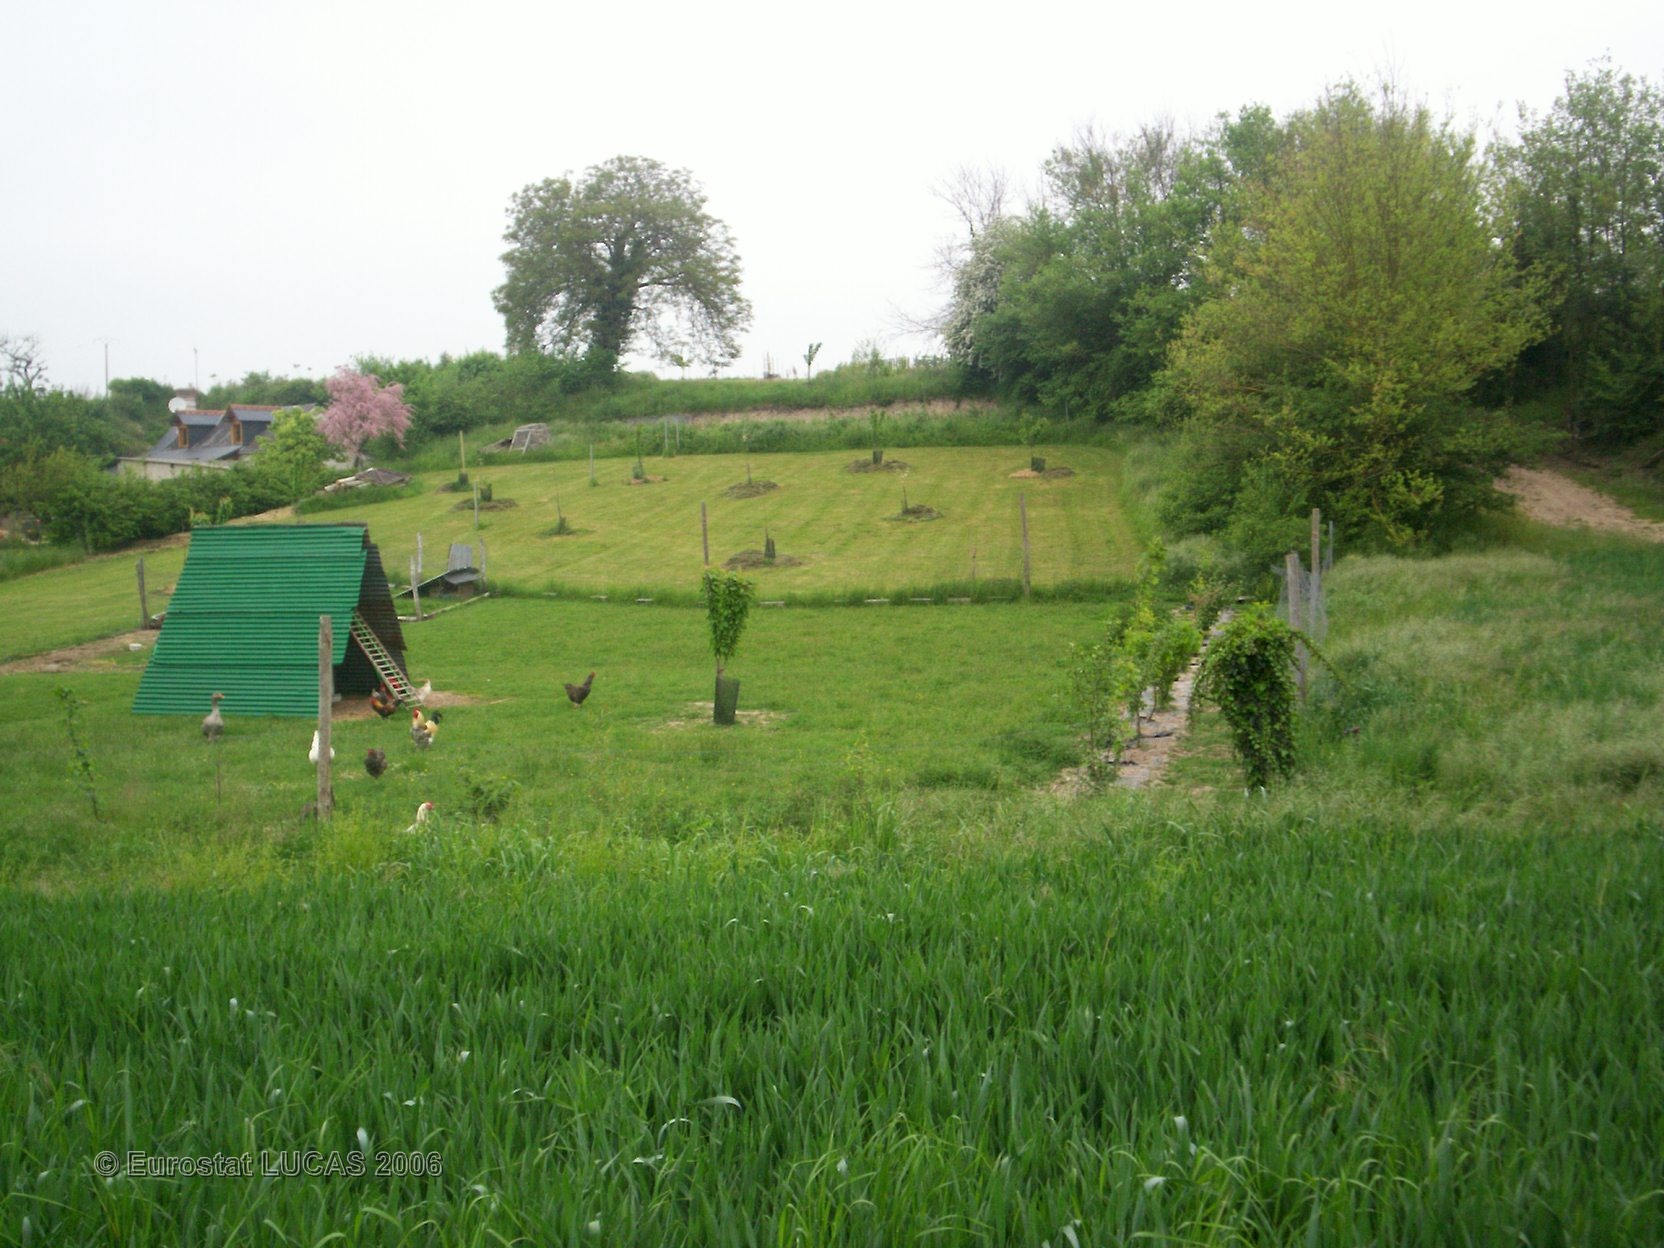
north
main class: Cropland
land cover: Common wheat
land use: Agriculture (excluding fallow land and kitchen gardens)
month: May
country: FR
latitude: 47.6482
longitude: 0.4860
